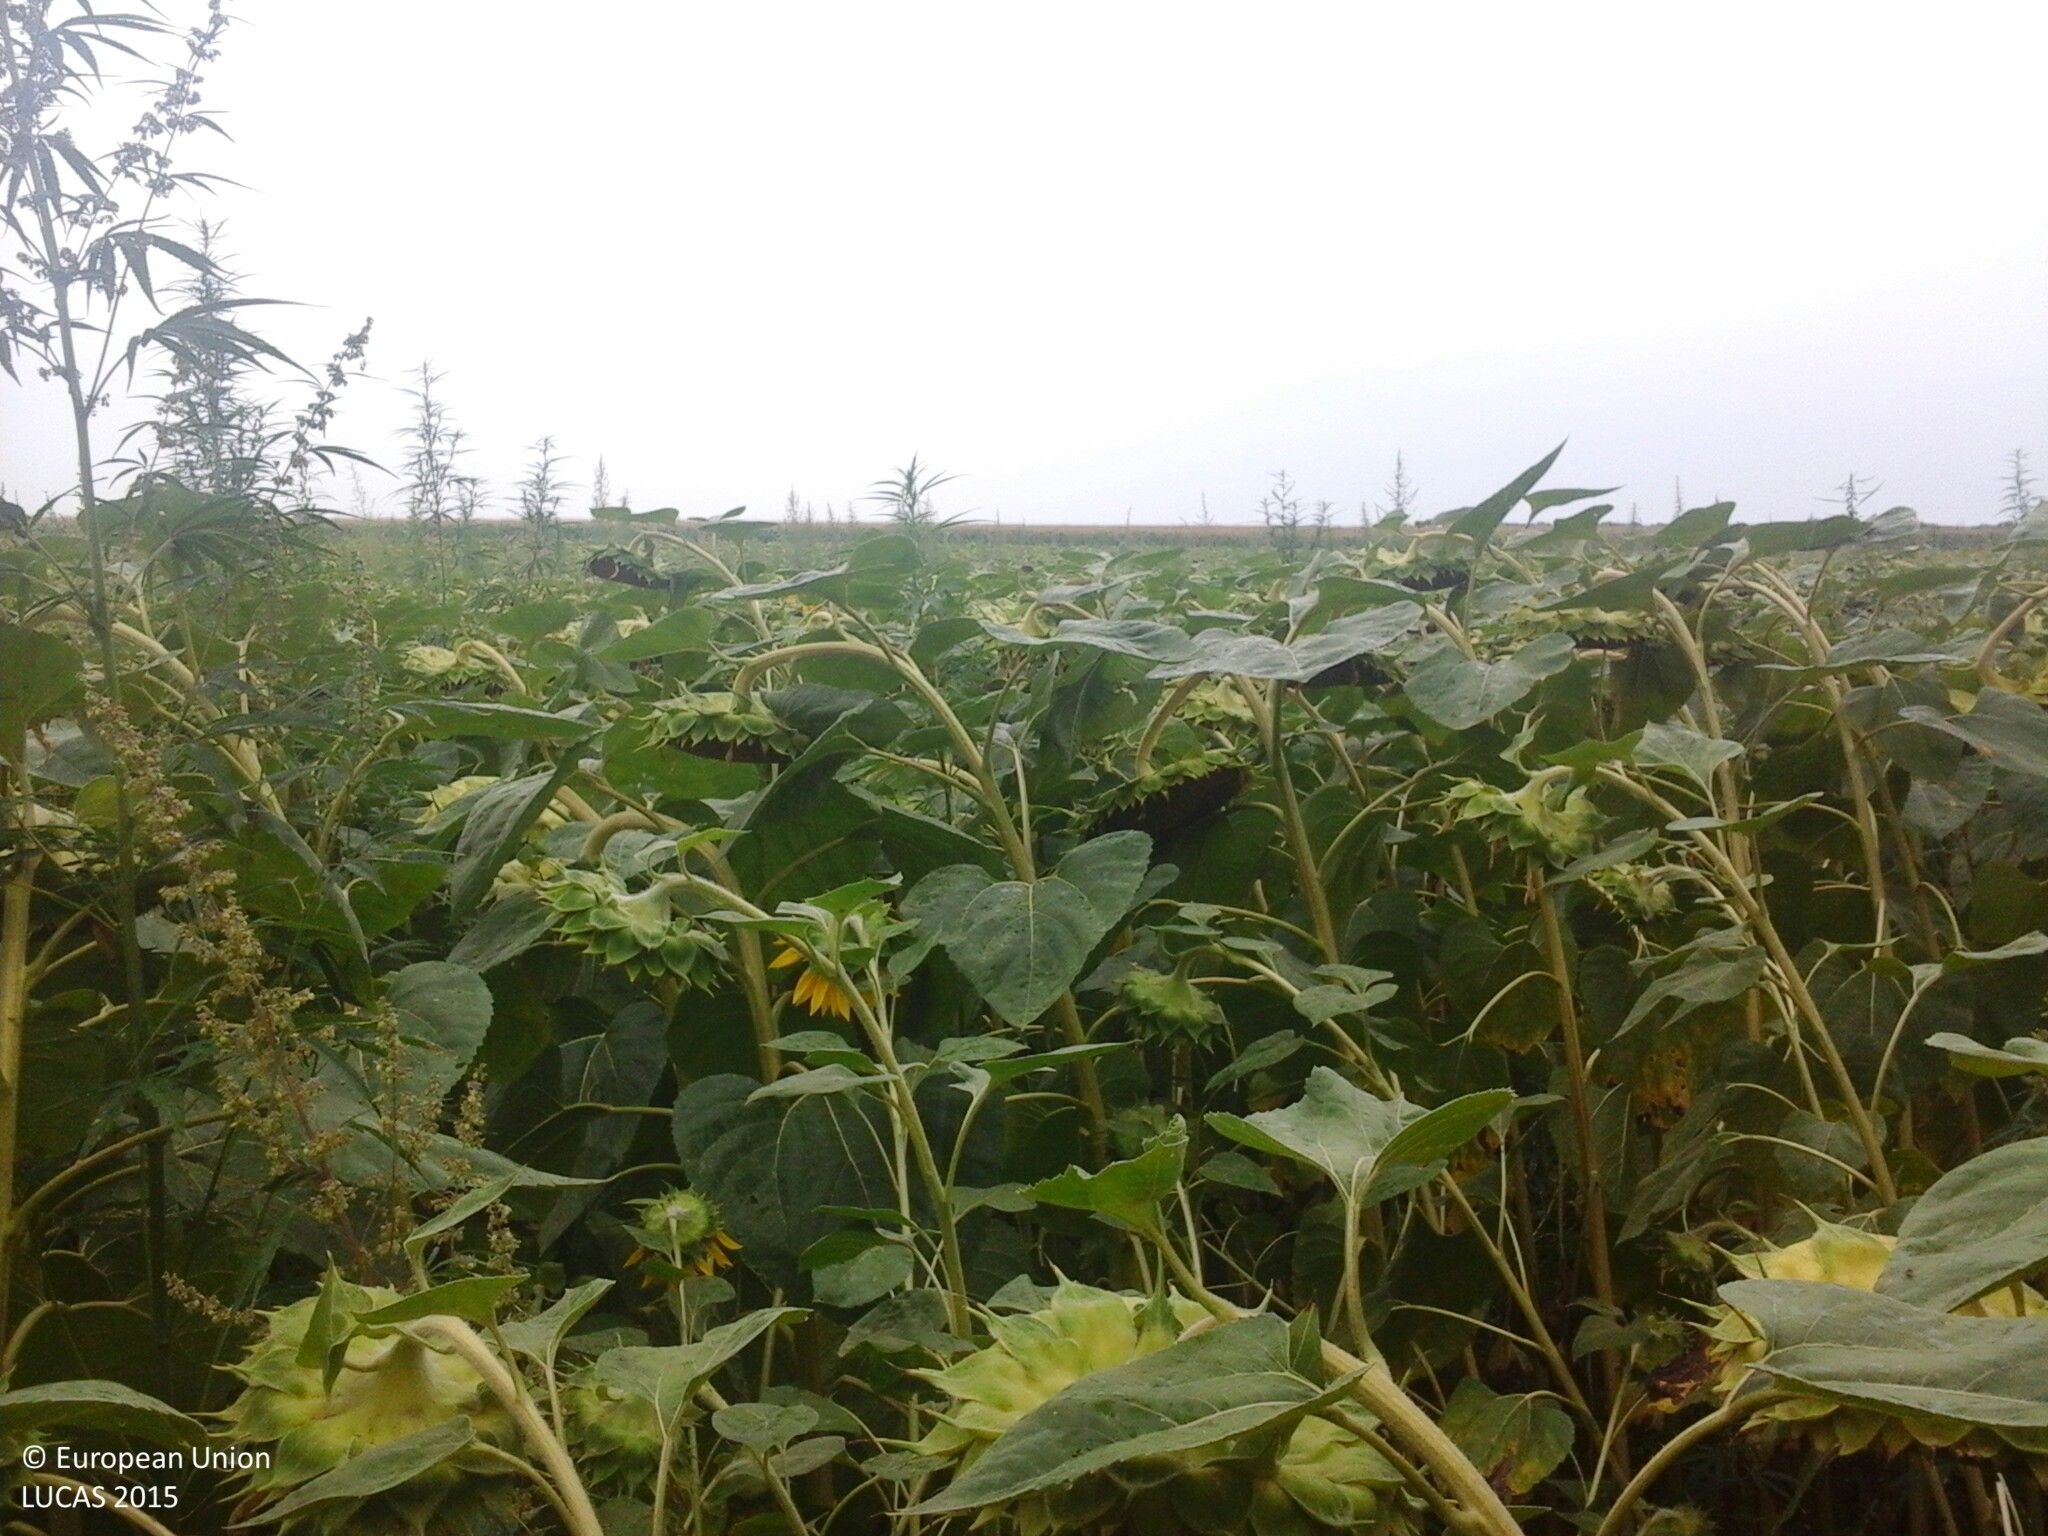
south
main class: Cropland
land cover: Sunflower
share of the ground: > 75 %
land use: Agriculture (excluding fallow land and kitchen gardens)
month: July
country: HU
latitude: 47.0008
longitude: 18.3623
